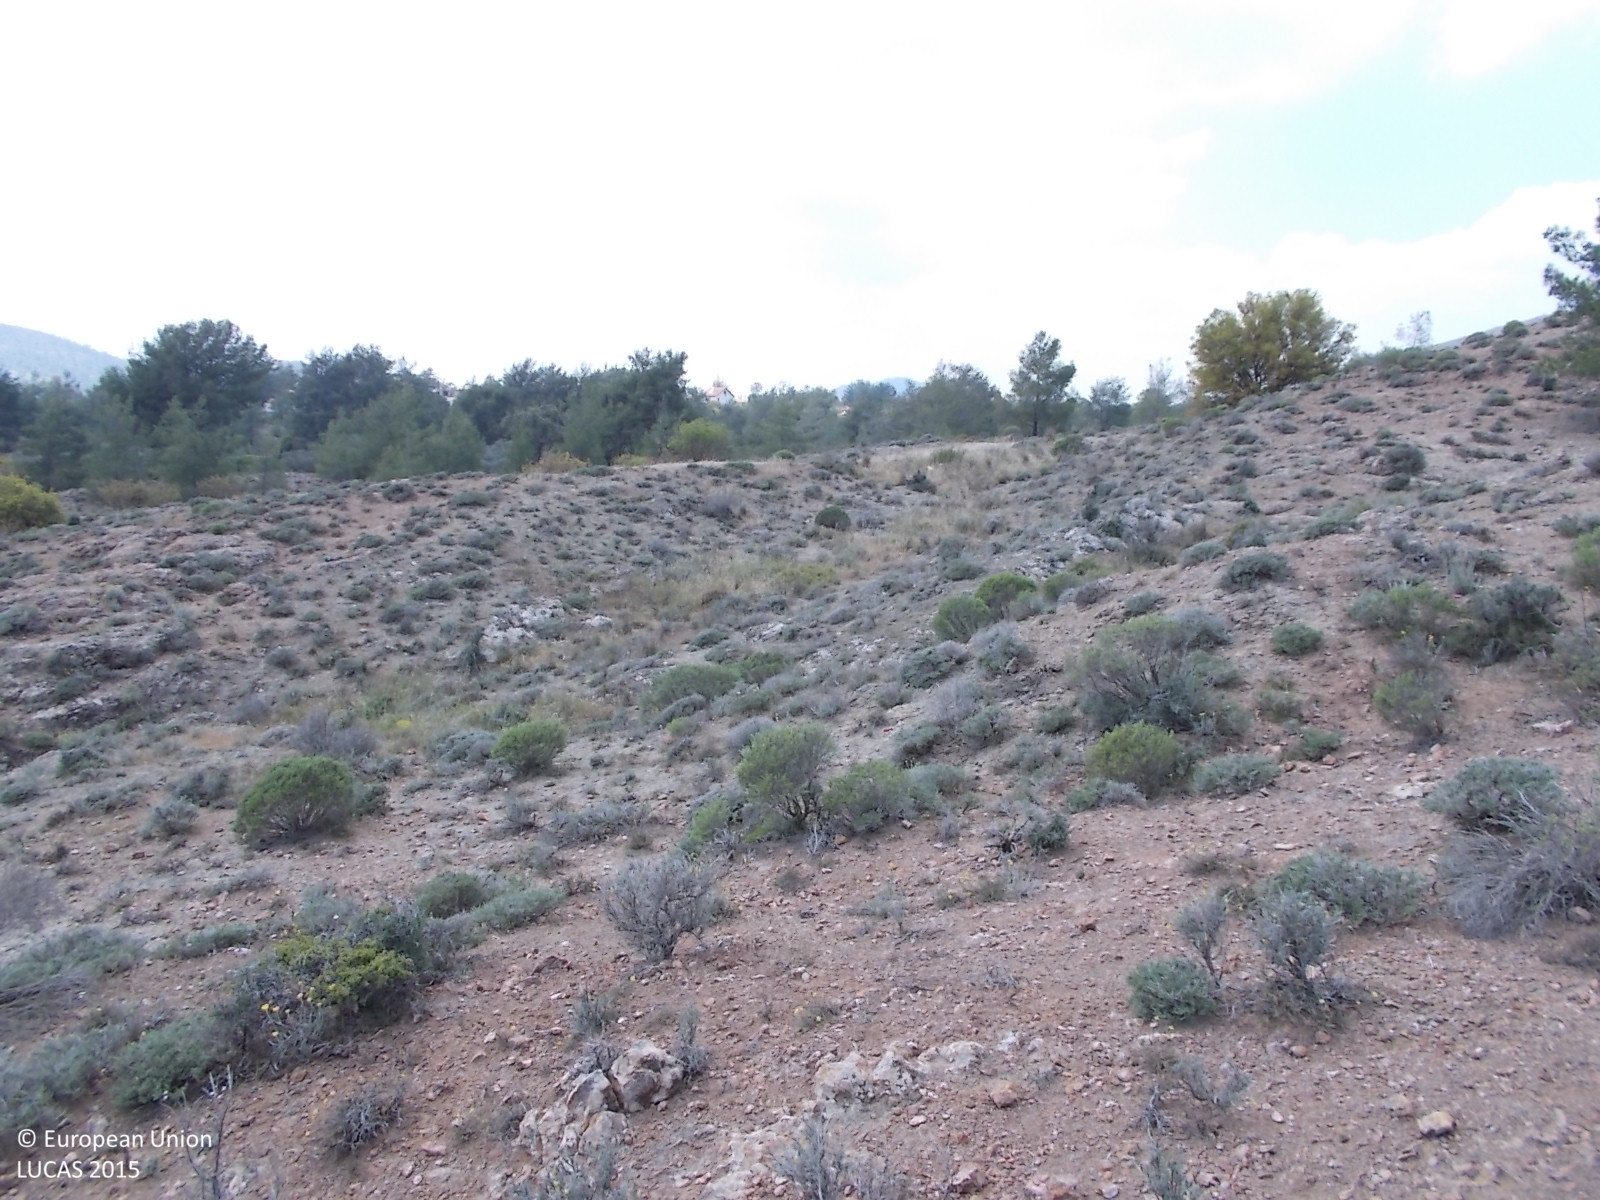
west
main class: Shrubland
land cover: Shrubland without tree cover
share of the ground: 25 - 50 %
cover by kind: unconsolidated bare surface 50 %, shrubs 45 %, consolidated bare surface 5 %
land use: Semi-natural and natural areas not in use
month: April
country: CY
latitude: 34.9217
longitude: 33.4502
